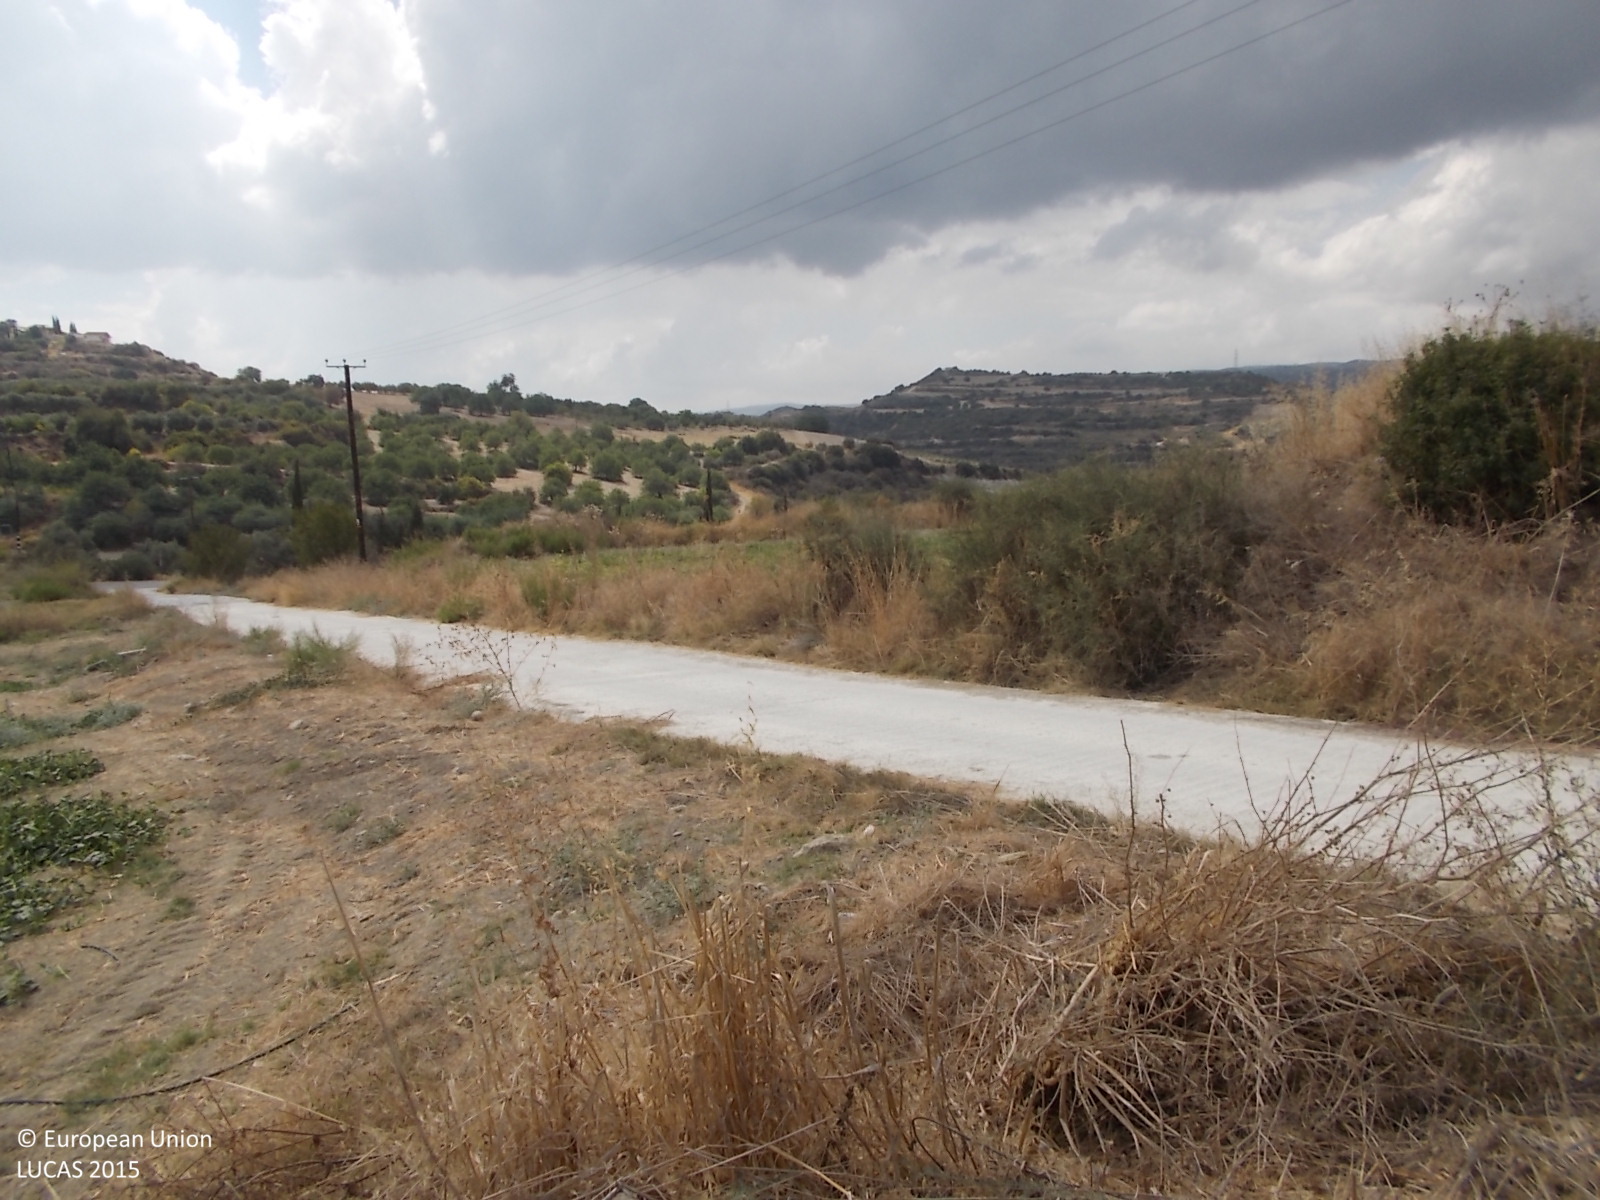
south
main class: Cropland
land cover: Dry pulses
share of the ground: > 75 %
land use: Agriculture (excluding fallow land and kitchen gardens)
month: June
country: CY
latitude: 34.9845
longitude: 32.4679
